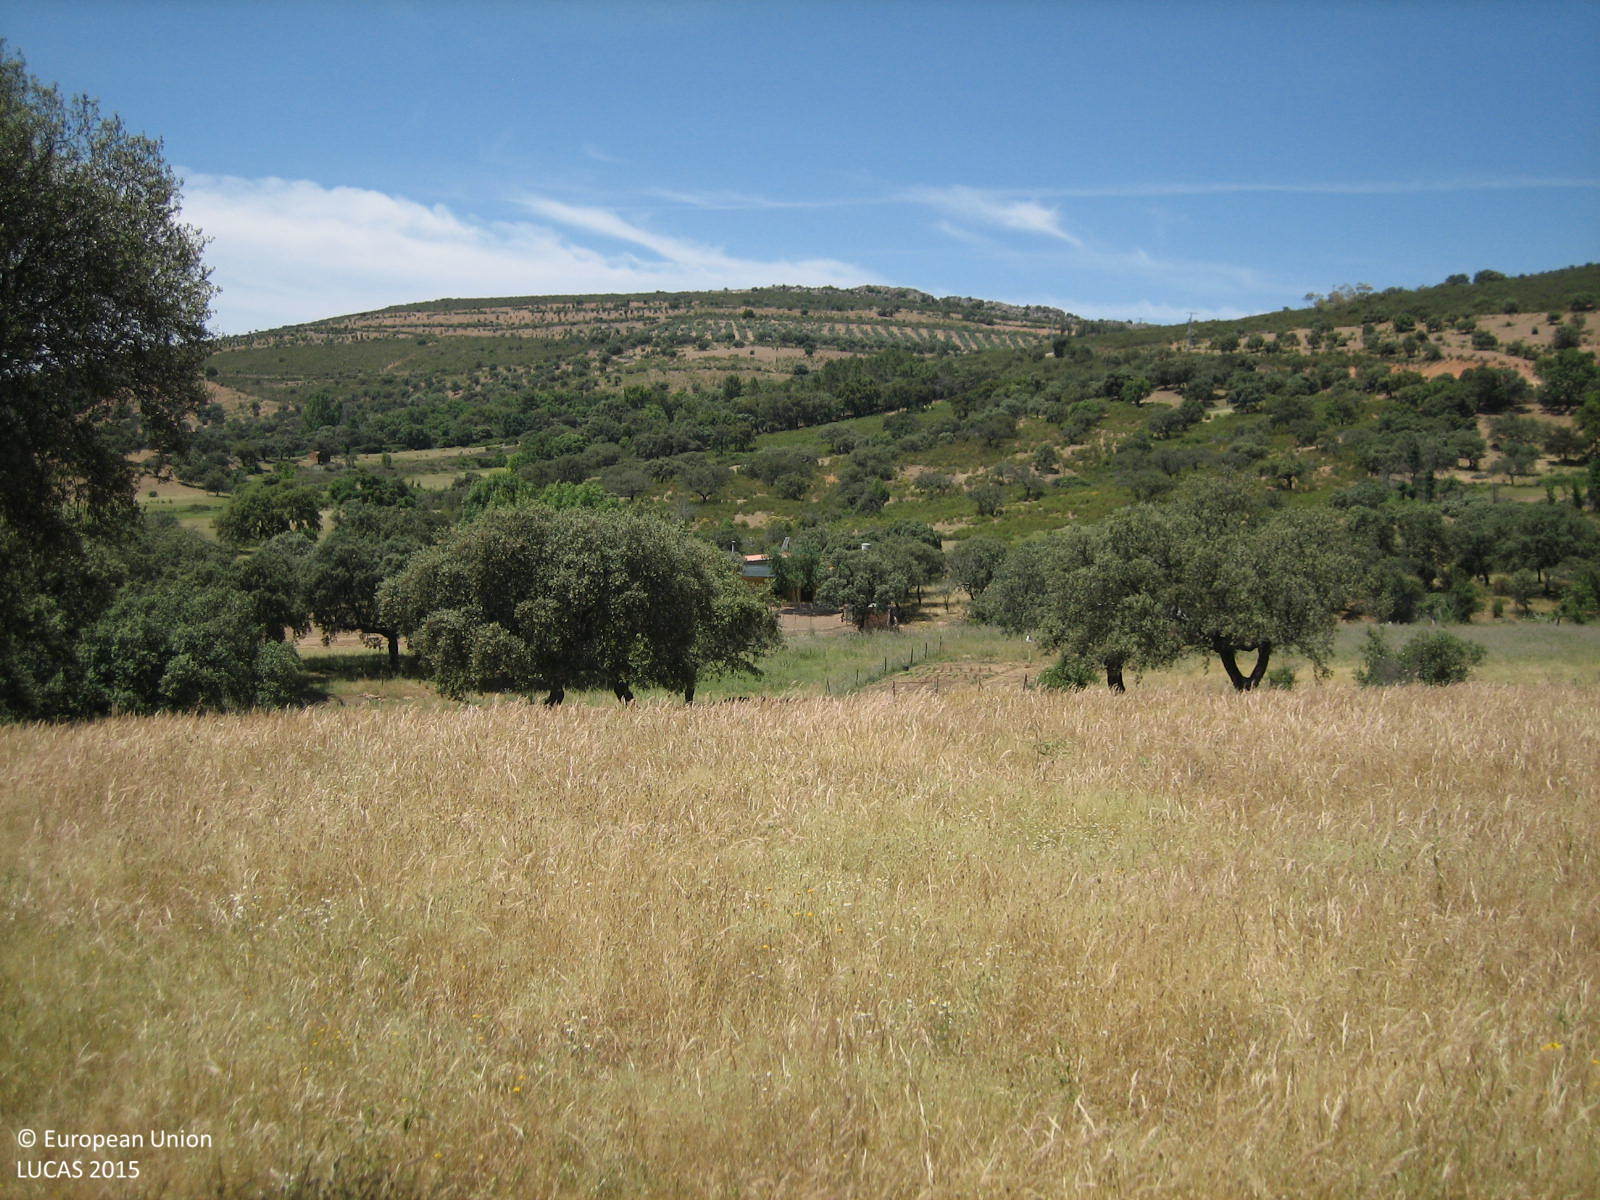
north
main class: Grassland
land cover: Grassland with sparse tree/shrub cover
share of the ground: > 75 %
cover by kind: herbaceous plants 75 %, broadleaved forest trees 5 %
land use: Agriculture (excluding fallow land and kitchen gardens)
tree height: > 5 m
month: May
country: ES
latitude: 39.0977
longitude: -4.9405
